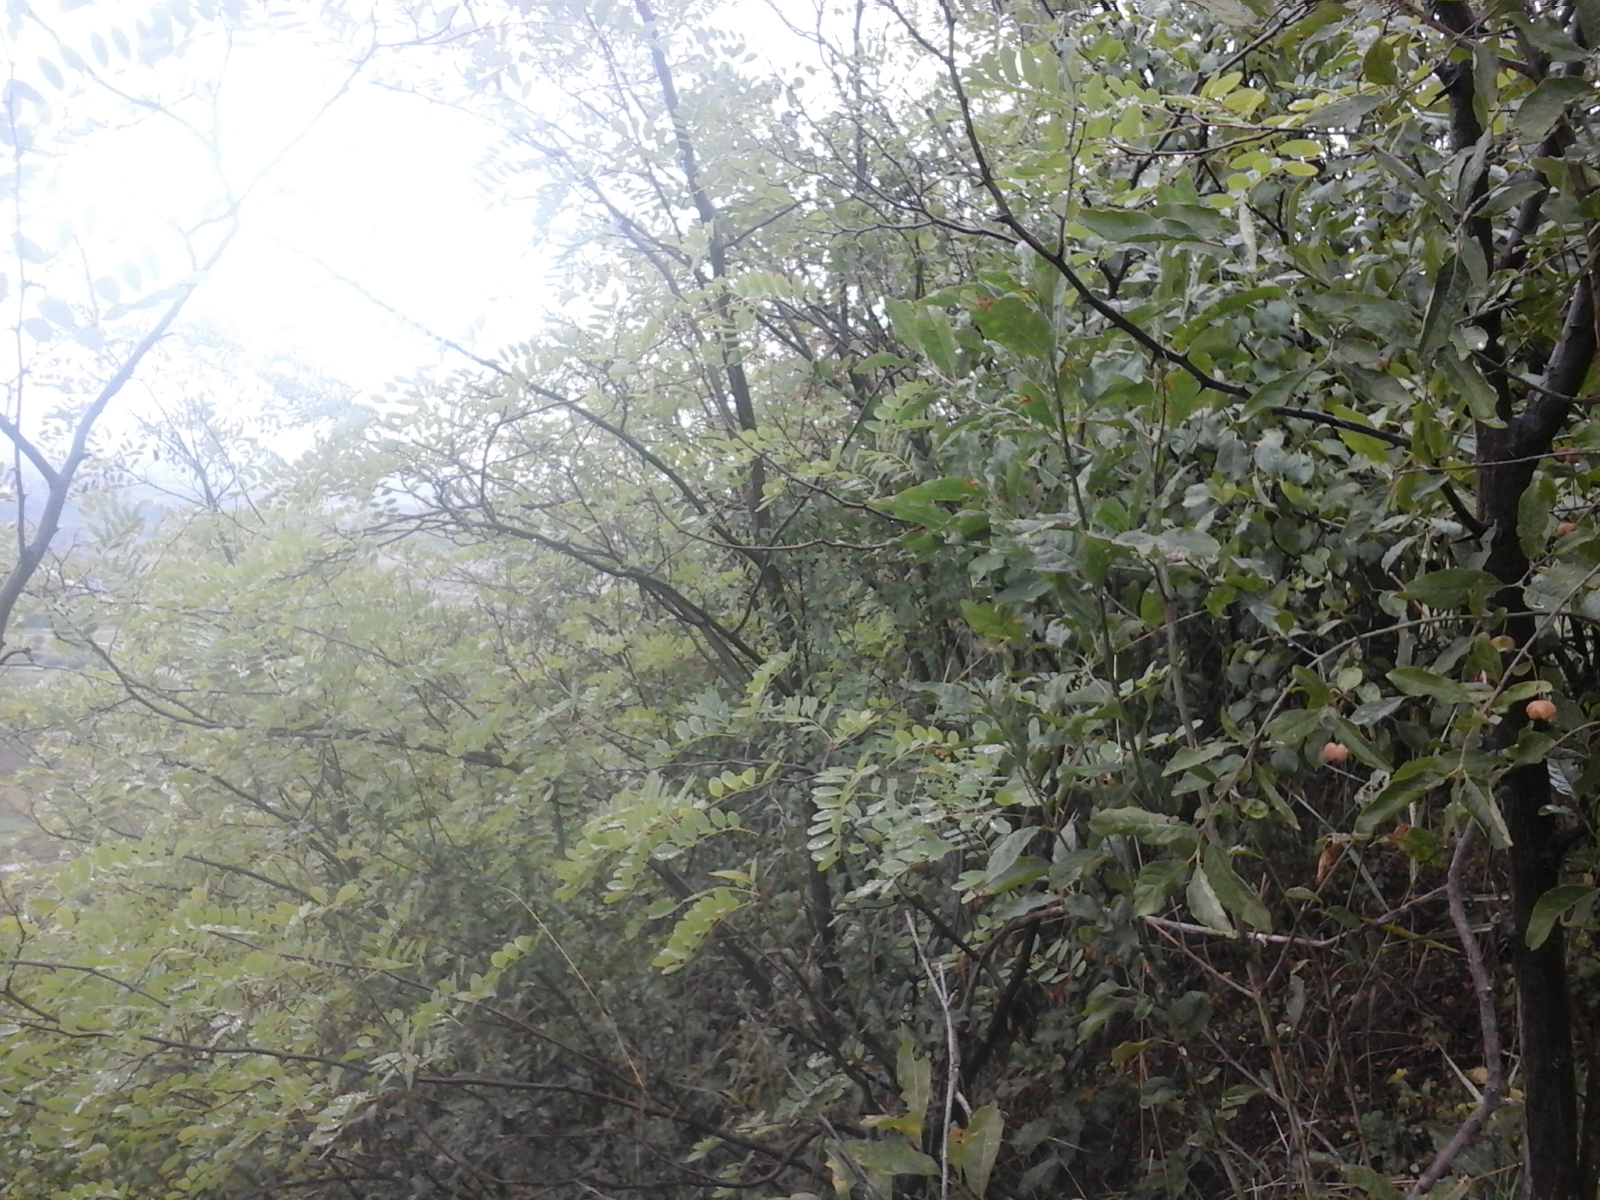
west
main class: Shrubland
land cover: Shrubland with sparse tree cover
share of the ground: > 75 %
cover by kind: shrubs 95 %, broadleaved forest trees 5 %
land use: Fallow land
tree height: < 5 m
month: September
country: RO
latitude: 47.2636
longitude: 22.5725
